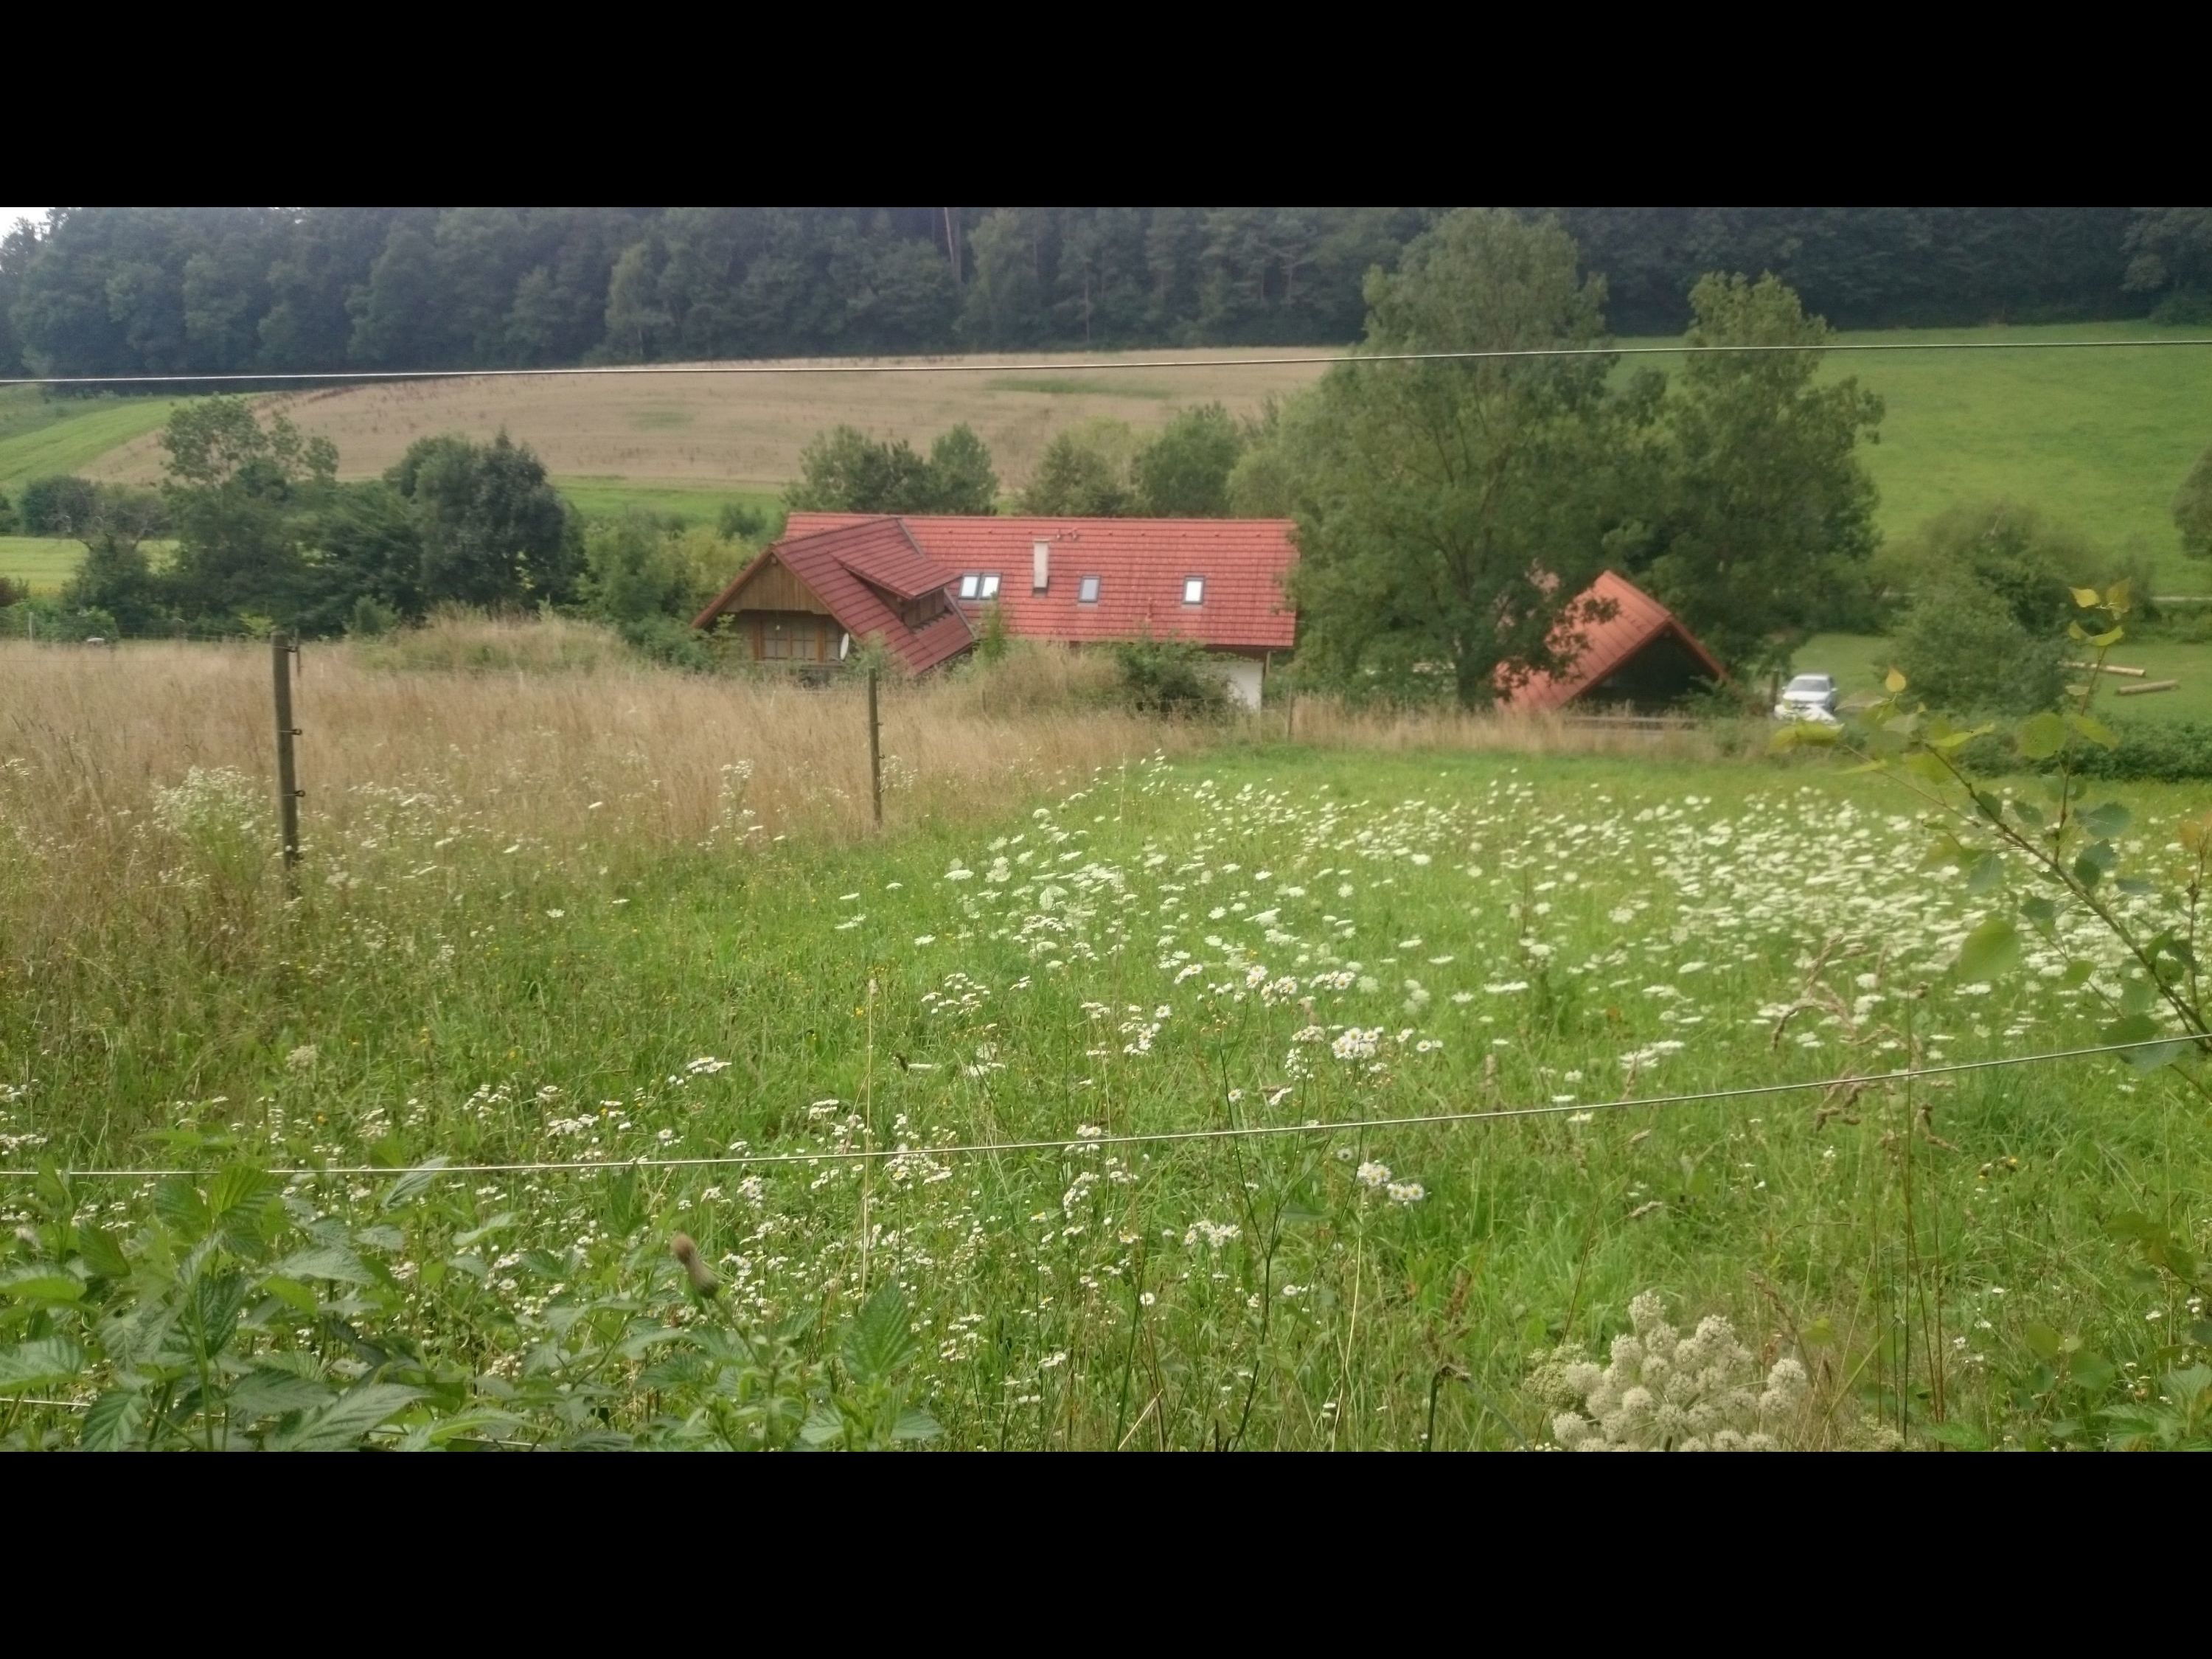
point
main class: Grassland
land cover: Grassland without tree/shrub cover
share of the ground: > 75 %
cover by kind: herbaceous plants 100 %
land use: Agriculture (excluding fallow land and kitchen gardens)
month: July
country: AT
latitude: 46.9617
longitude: 15.9540
